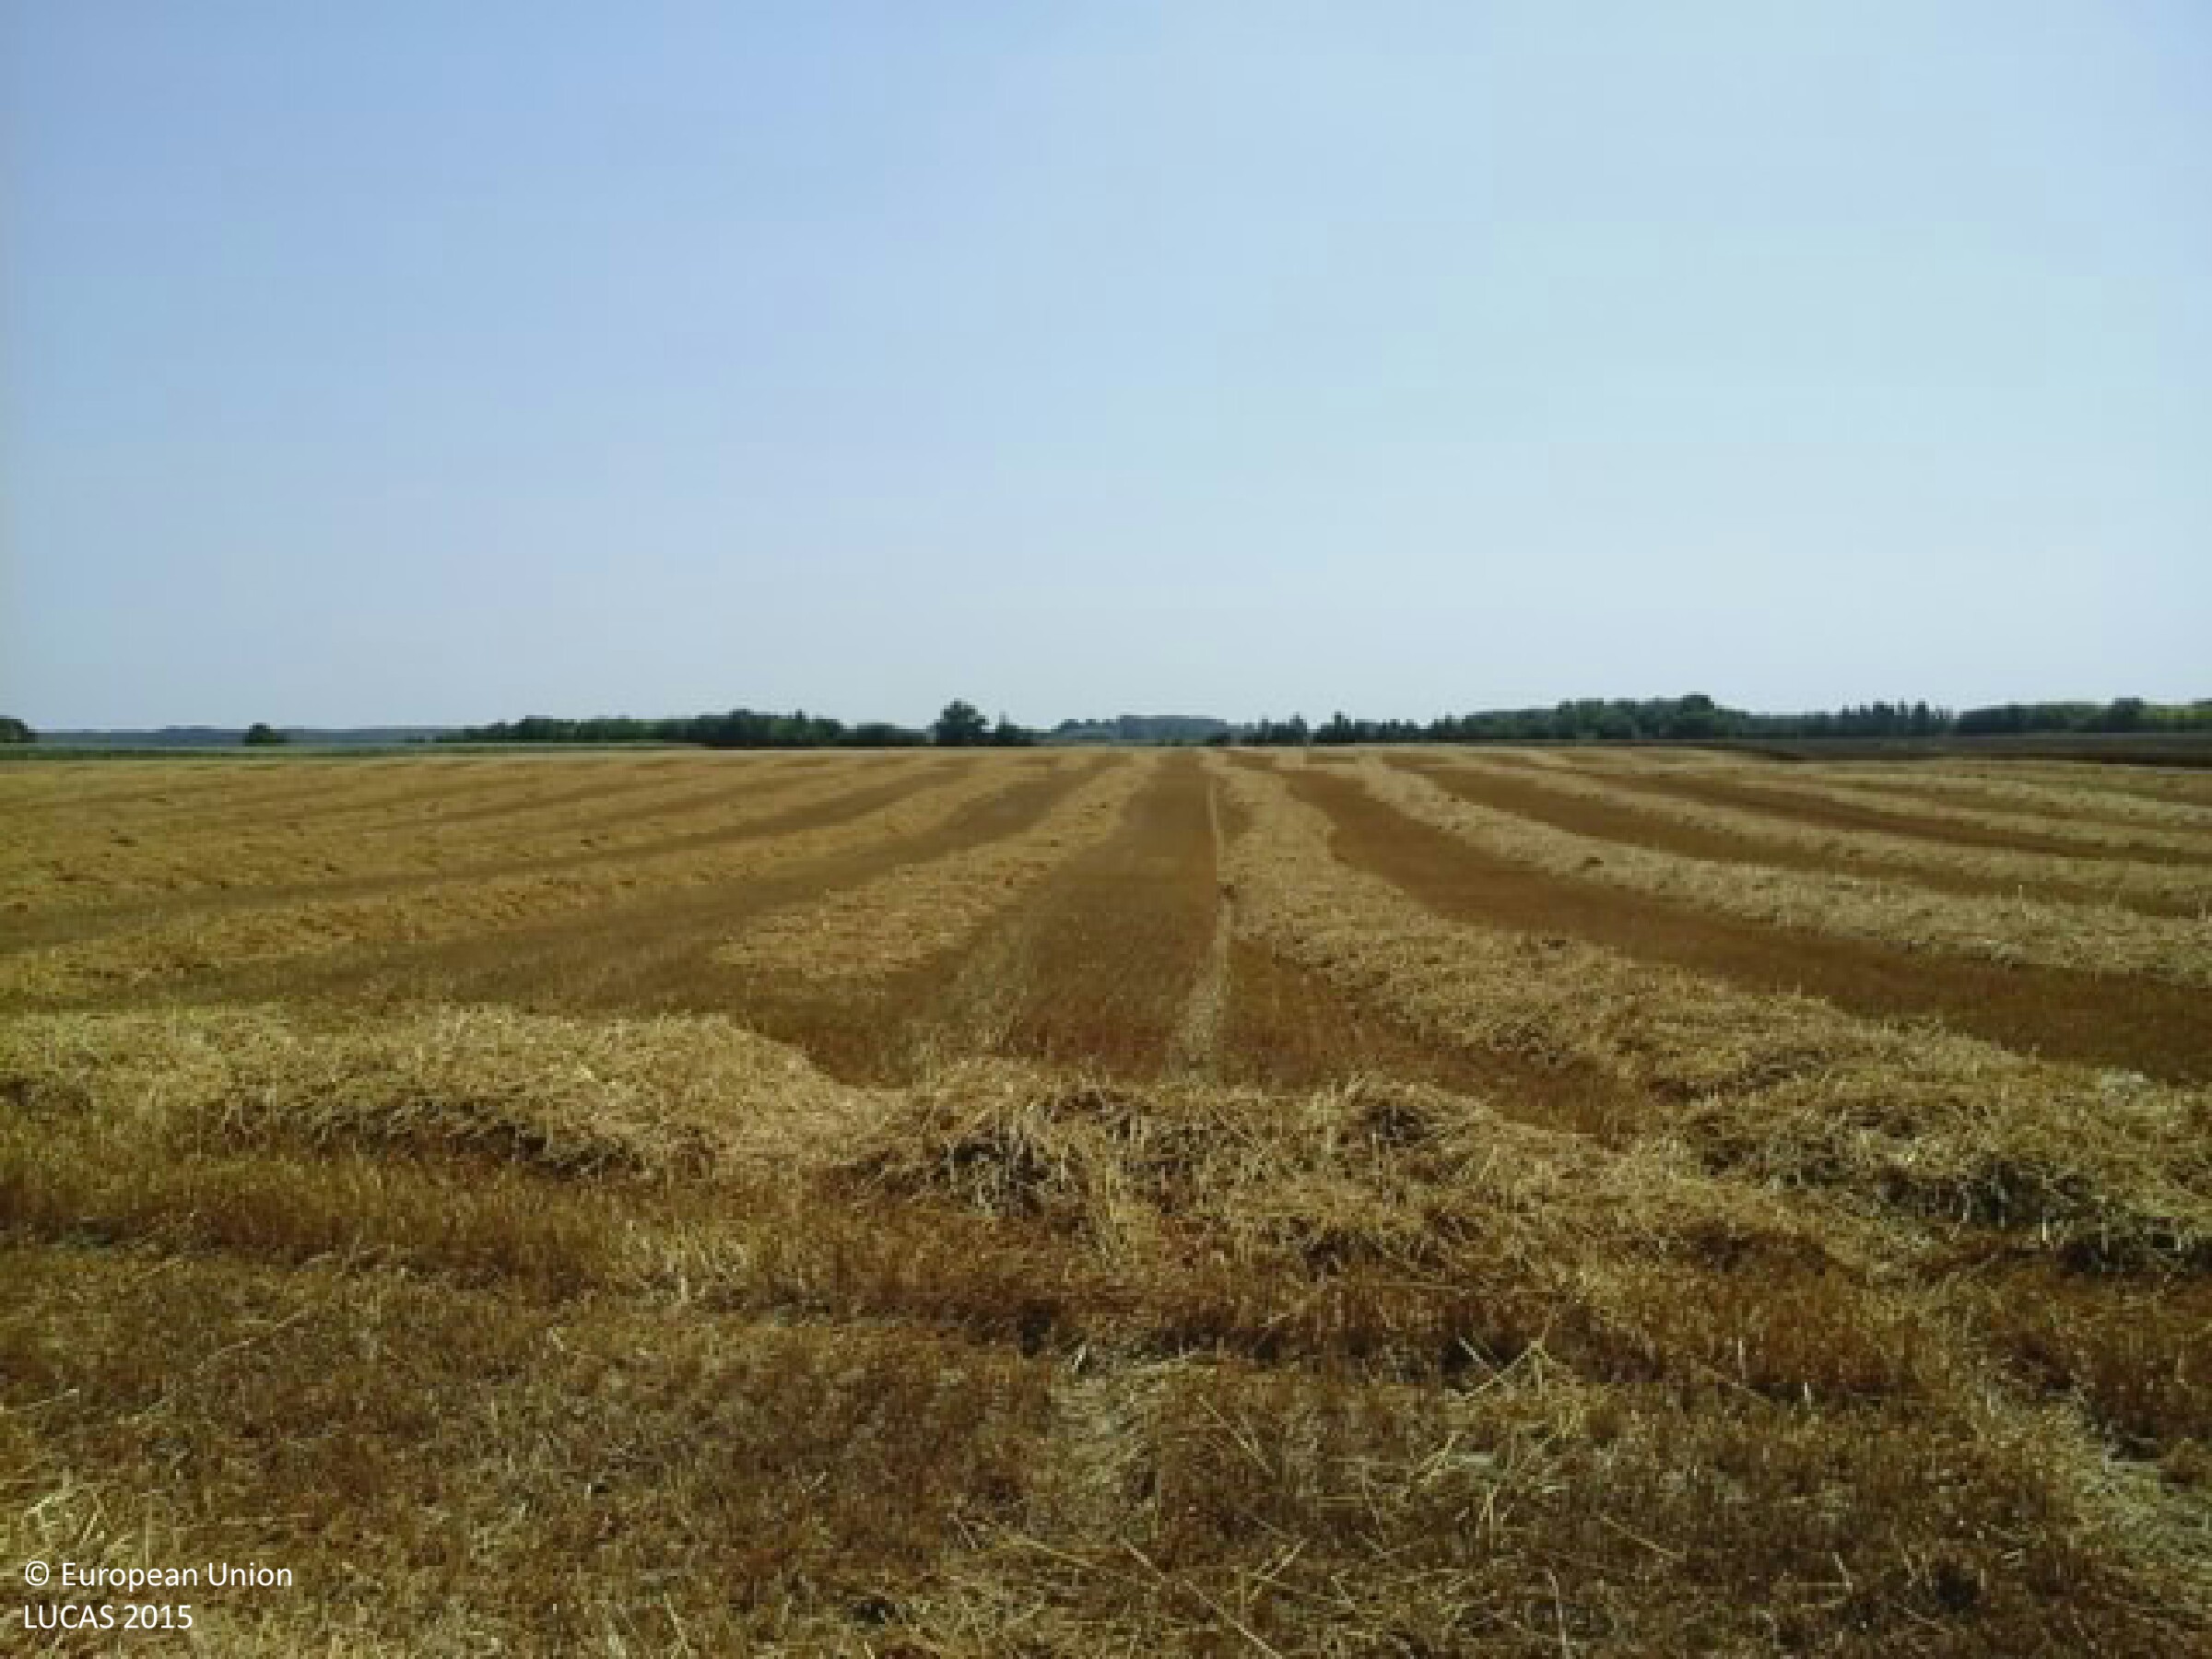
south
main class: Cropland
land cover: Common wheat
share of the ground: 50 - 75 %
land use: Agriculture (excluding fallow land and kitchen gardens)
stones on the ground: < 10 %
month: July
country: HU
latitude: 46.2580
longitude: 18.8200
